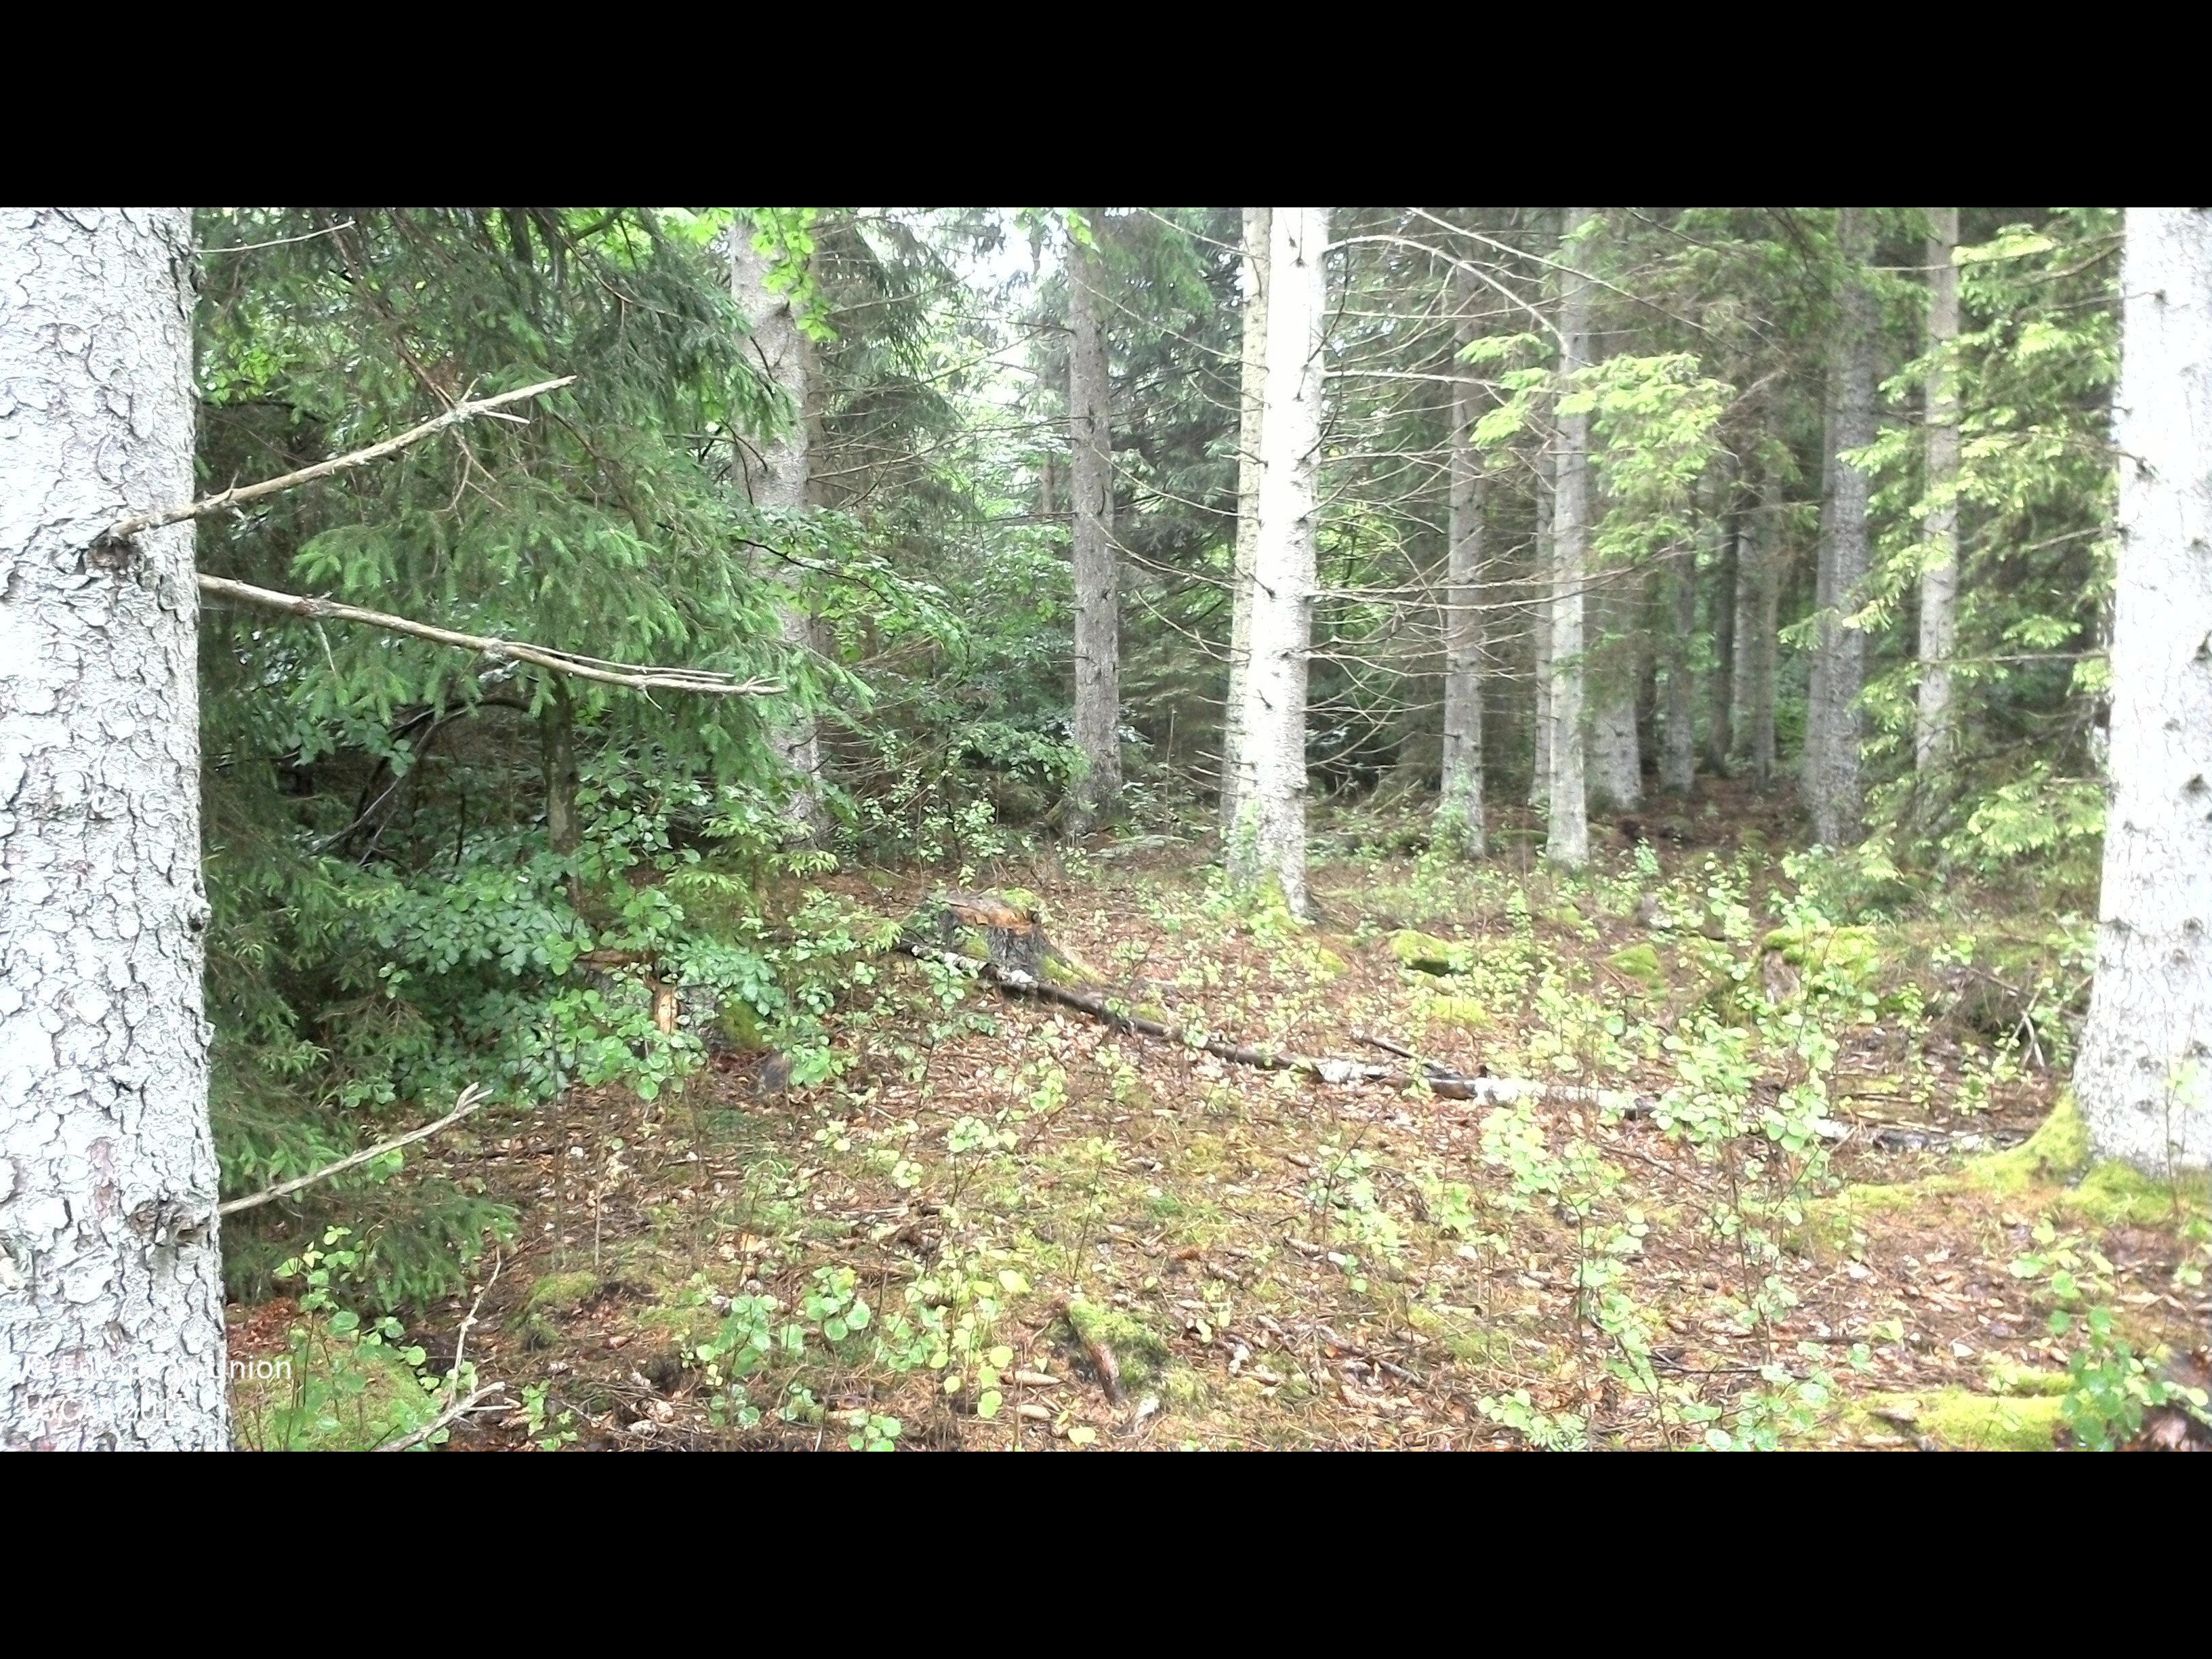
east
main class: Woodland
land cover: Spruce dominated coniferous woodland
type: boreal forest
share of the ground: > 75 %
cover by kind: coniferous forest trees 65 %, lichens and mosses 15 %, broadleaved forest trees 10 %, herbaceous plants 10 %
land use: Forestry
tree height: > 5 m
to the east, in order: Spruce dominated coniferous woodland; Broadleaved woodland; Rivers and streams; Broadleaved woodland
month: June
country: SE
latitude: 56.4284
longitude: 15.9511
